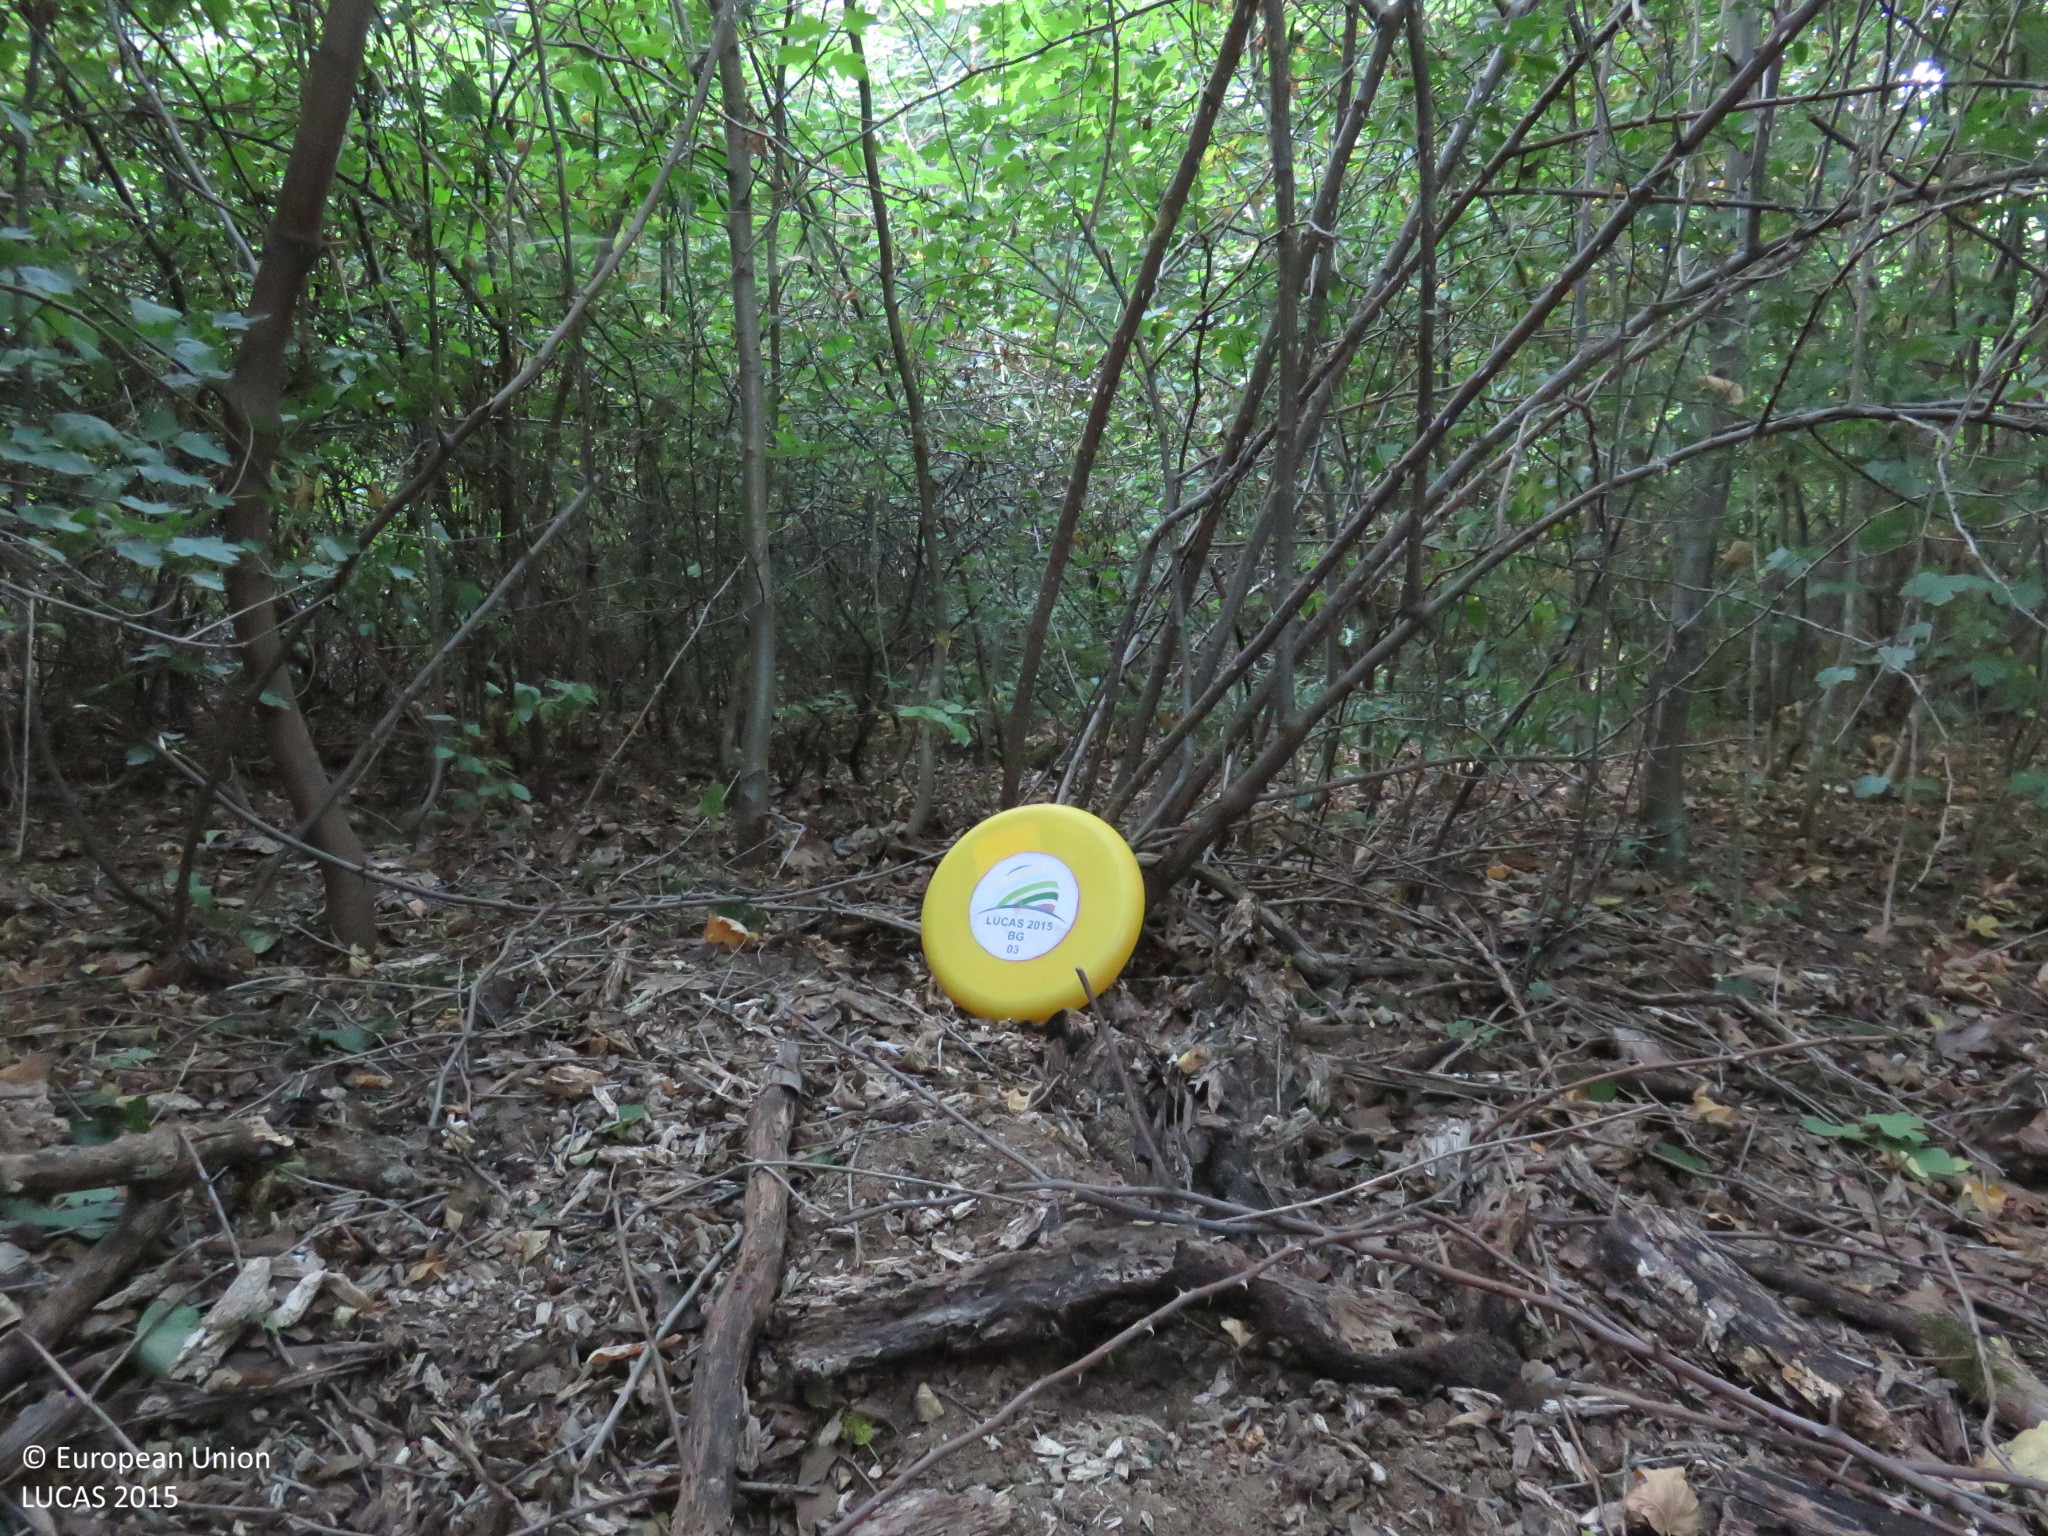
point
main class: Woodland
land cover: Broadleaved woodland
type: mesophytic deciduous forest
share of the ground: > 75 %
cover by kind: broadleaved forest trees 75 %, shrubs 25 %
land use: Forestry
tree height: < 5 m
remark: Clear cut
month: July
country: BG
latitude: 43.2438
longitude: 25.1833
